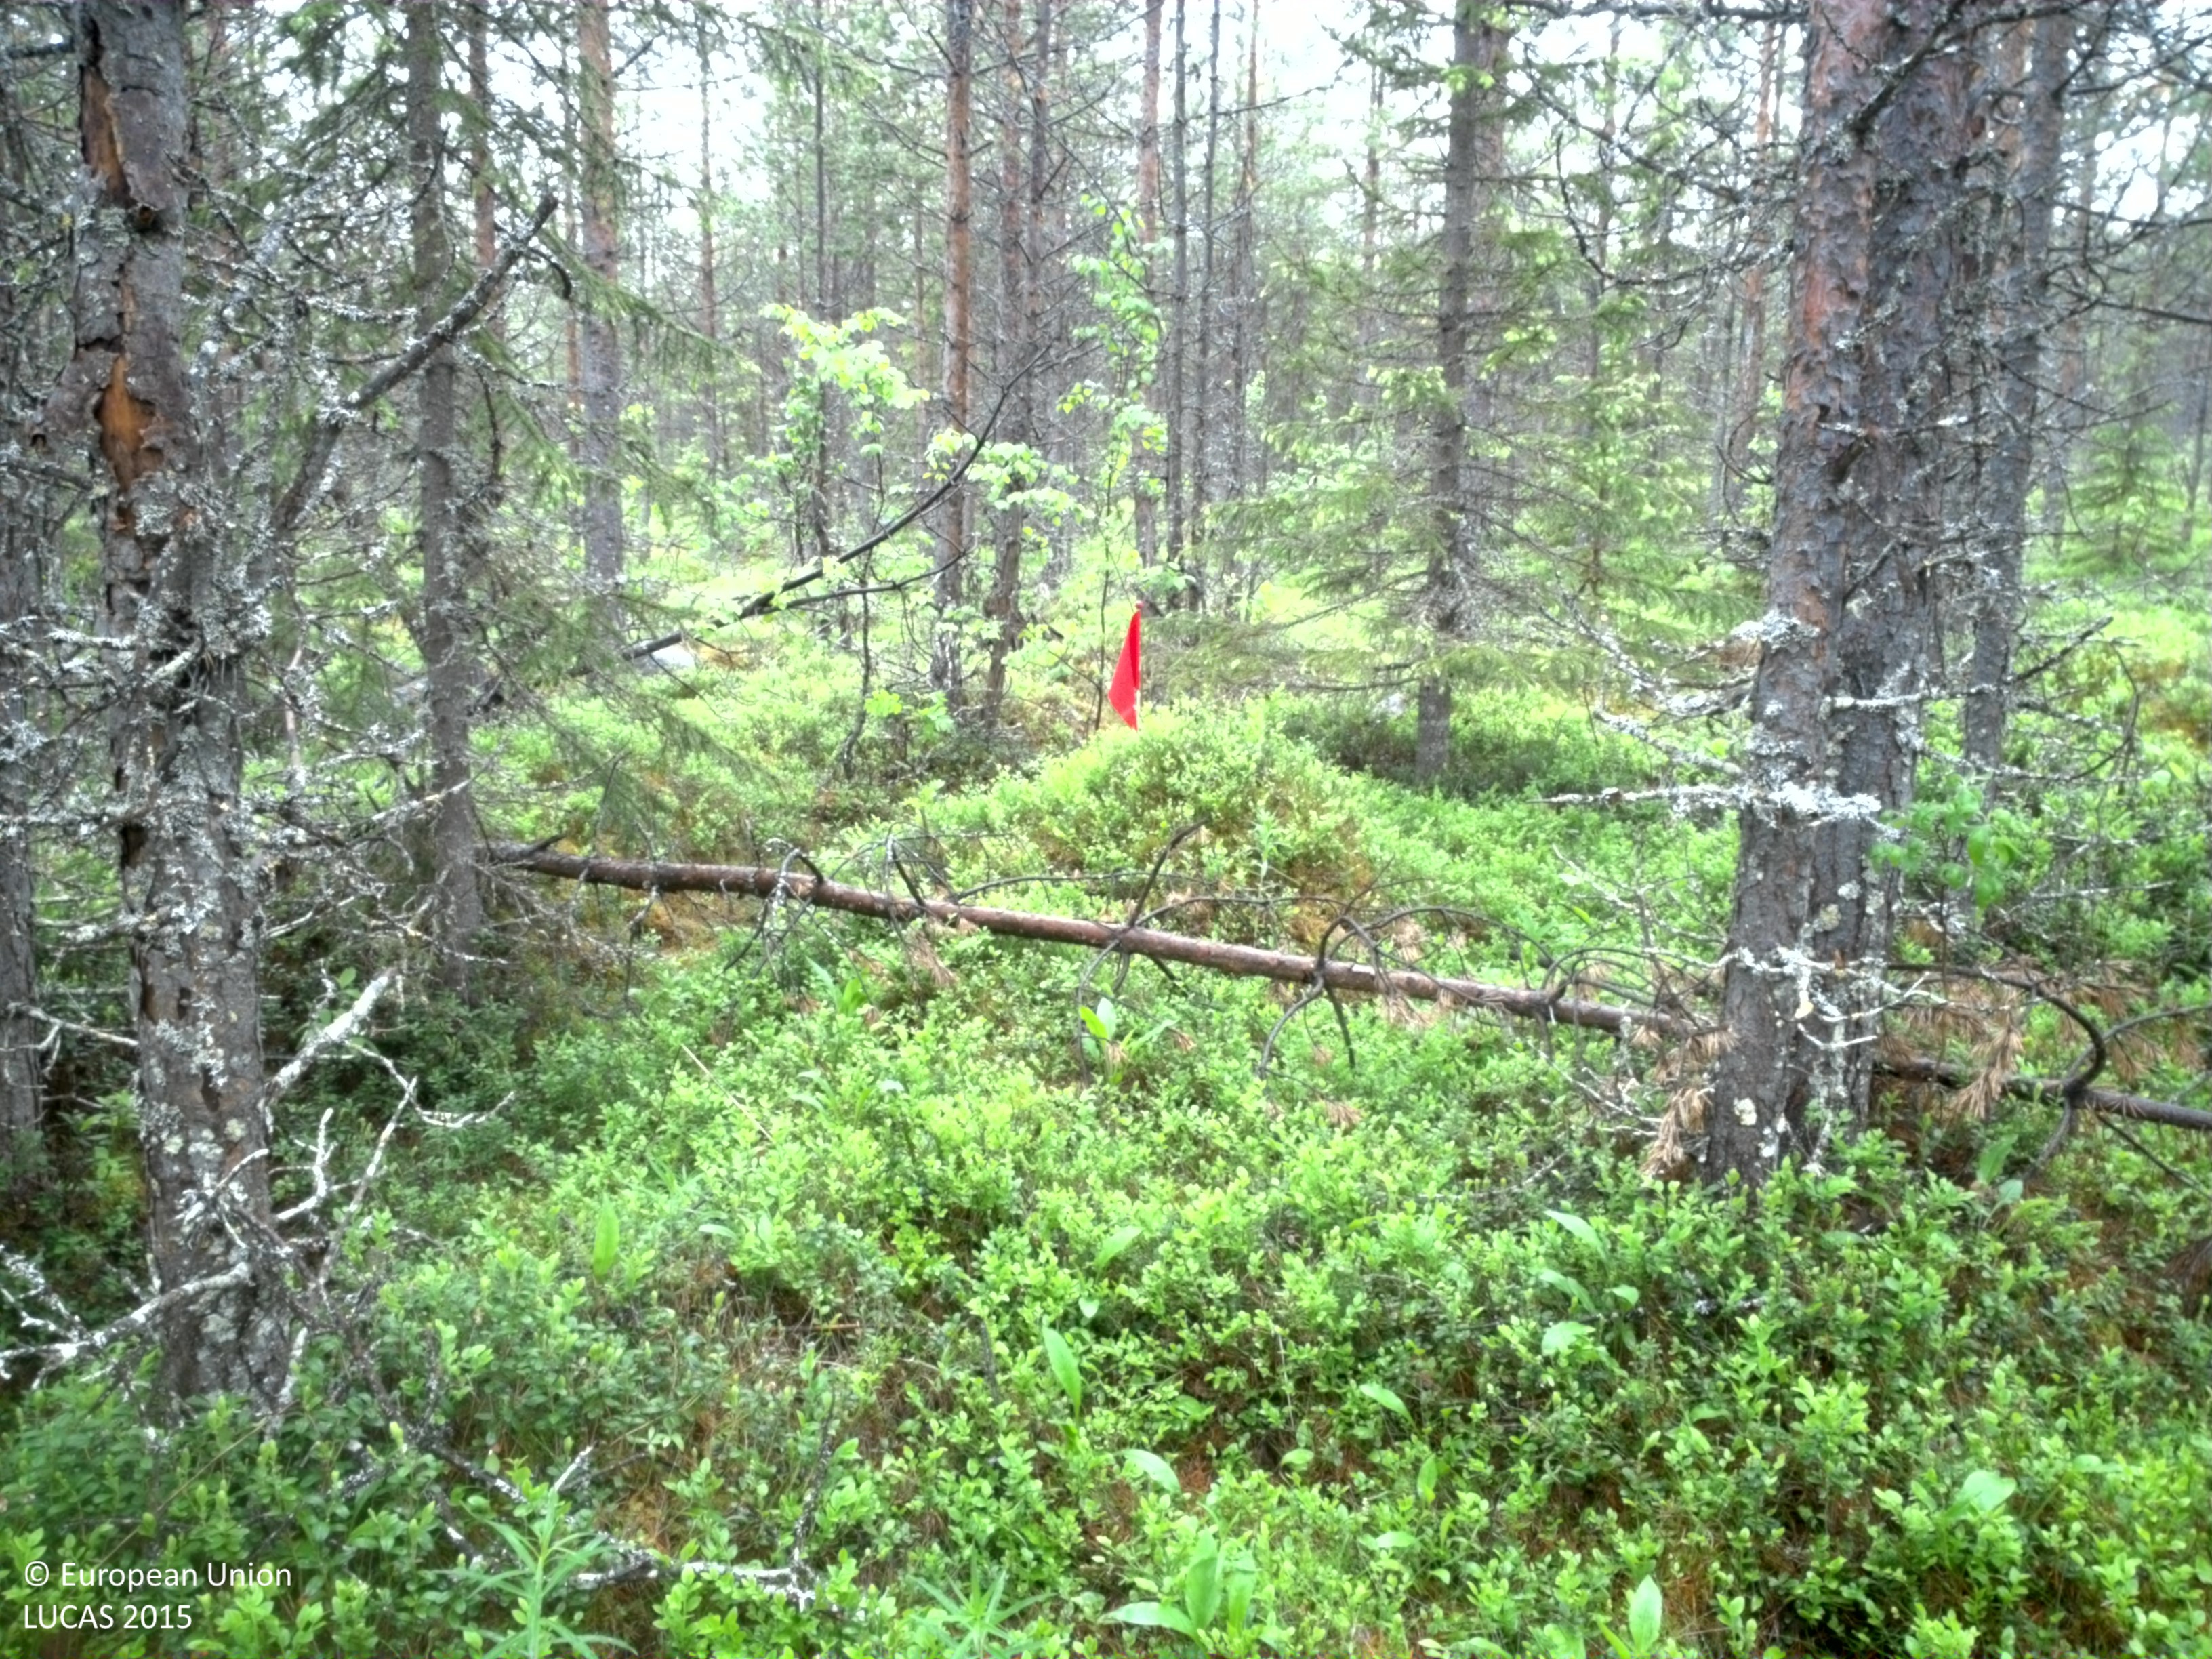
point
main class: Woodland
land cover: Pine dominated coniferous woodland
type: boreal forest
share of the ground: 25 - 50 %
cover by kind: shrubs 55 %, coniferous forest trees 40 %, broadleaved forest trees 5 %
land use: Forestry
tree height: > 5 m
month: June
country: SE
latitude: 66.5566
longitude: 22.8365
